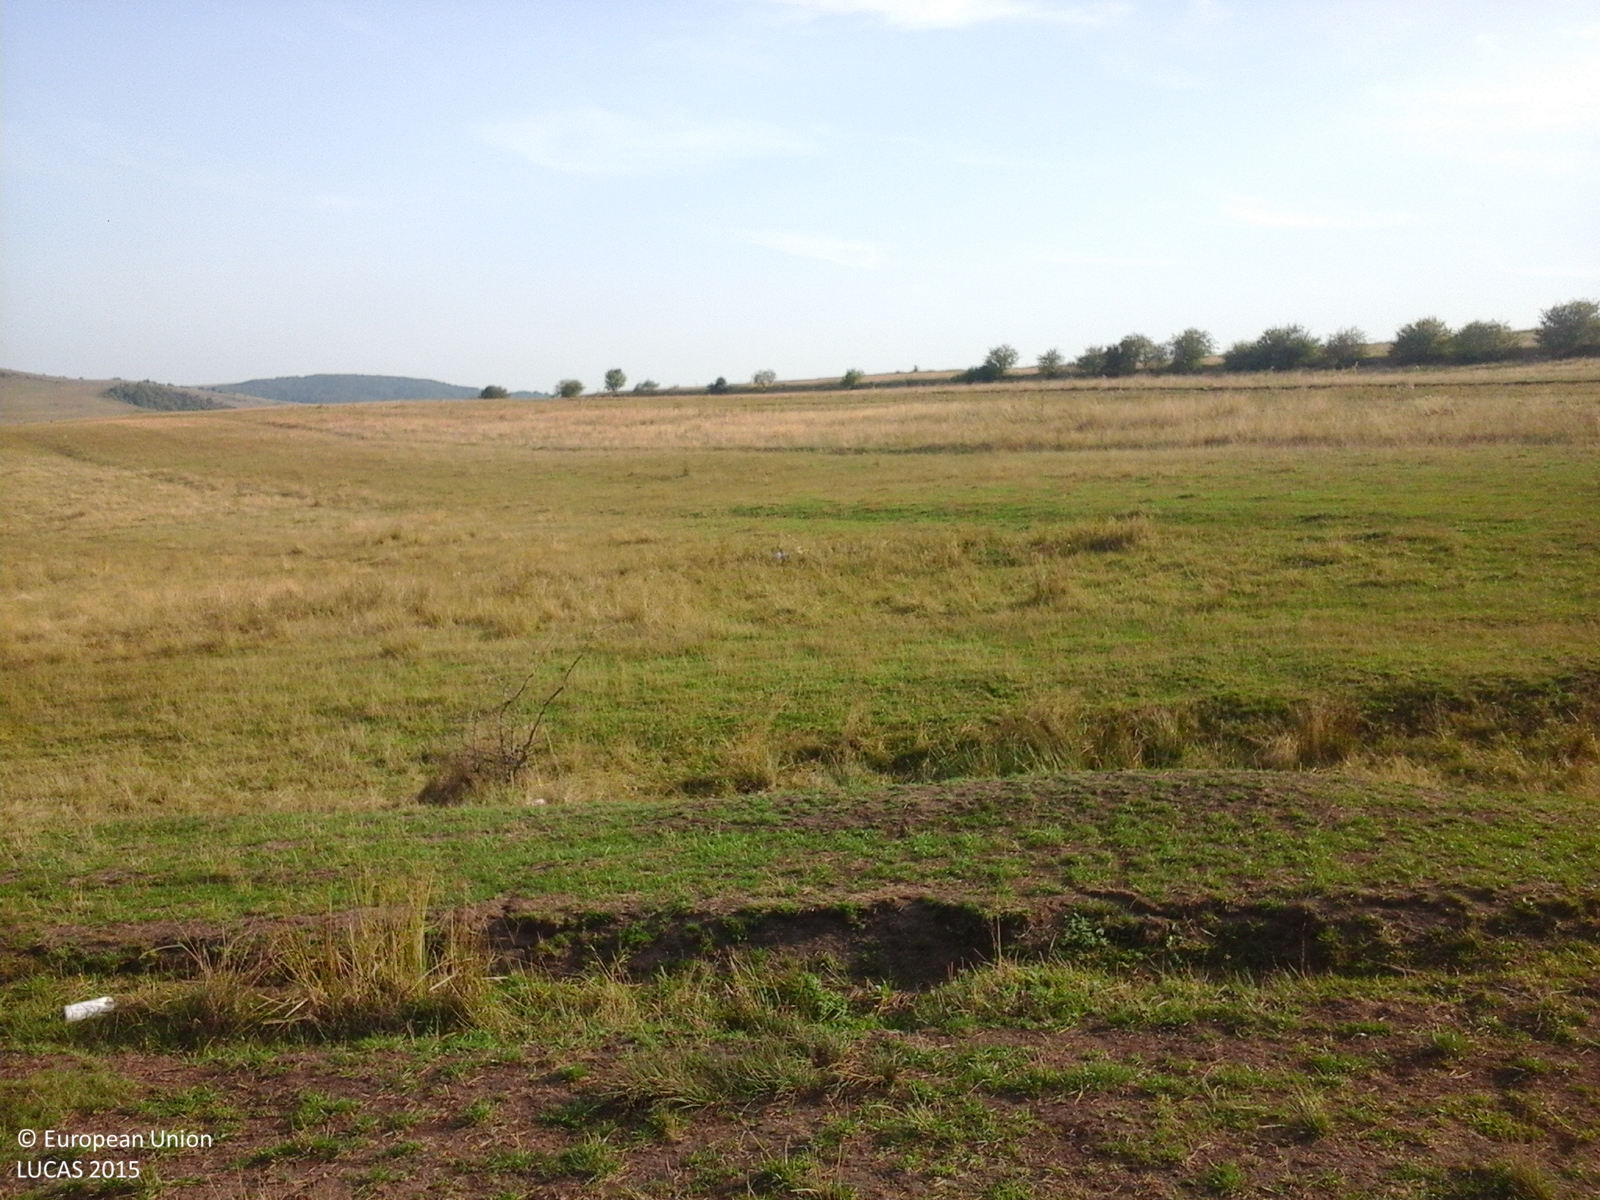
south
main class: Grassland
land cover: Grassland without tree/shrub cover
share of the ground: > 75 %
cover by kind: herbaceous plants 100 %
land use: Agriculture (excluding fallow land and kitchen gardens)
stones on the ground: < 10 %
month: September
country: RO
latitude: 47.1113
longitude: 23.5272
